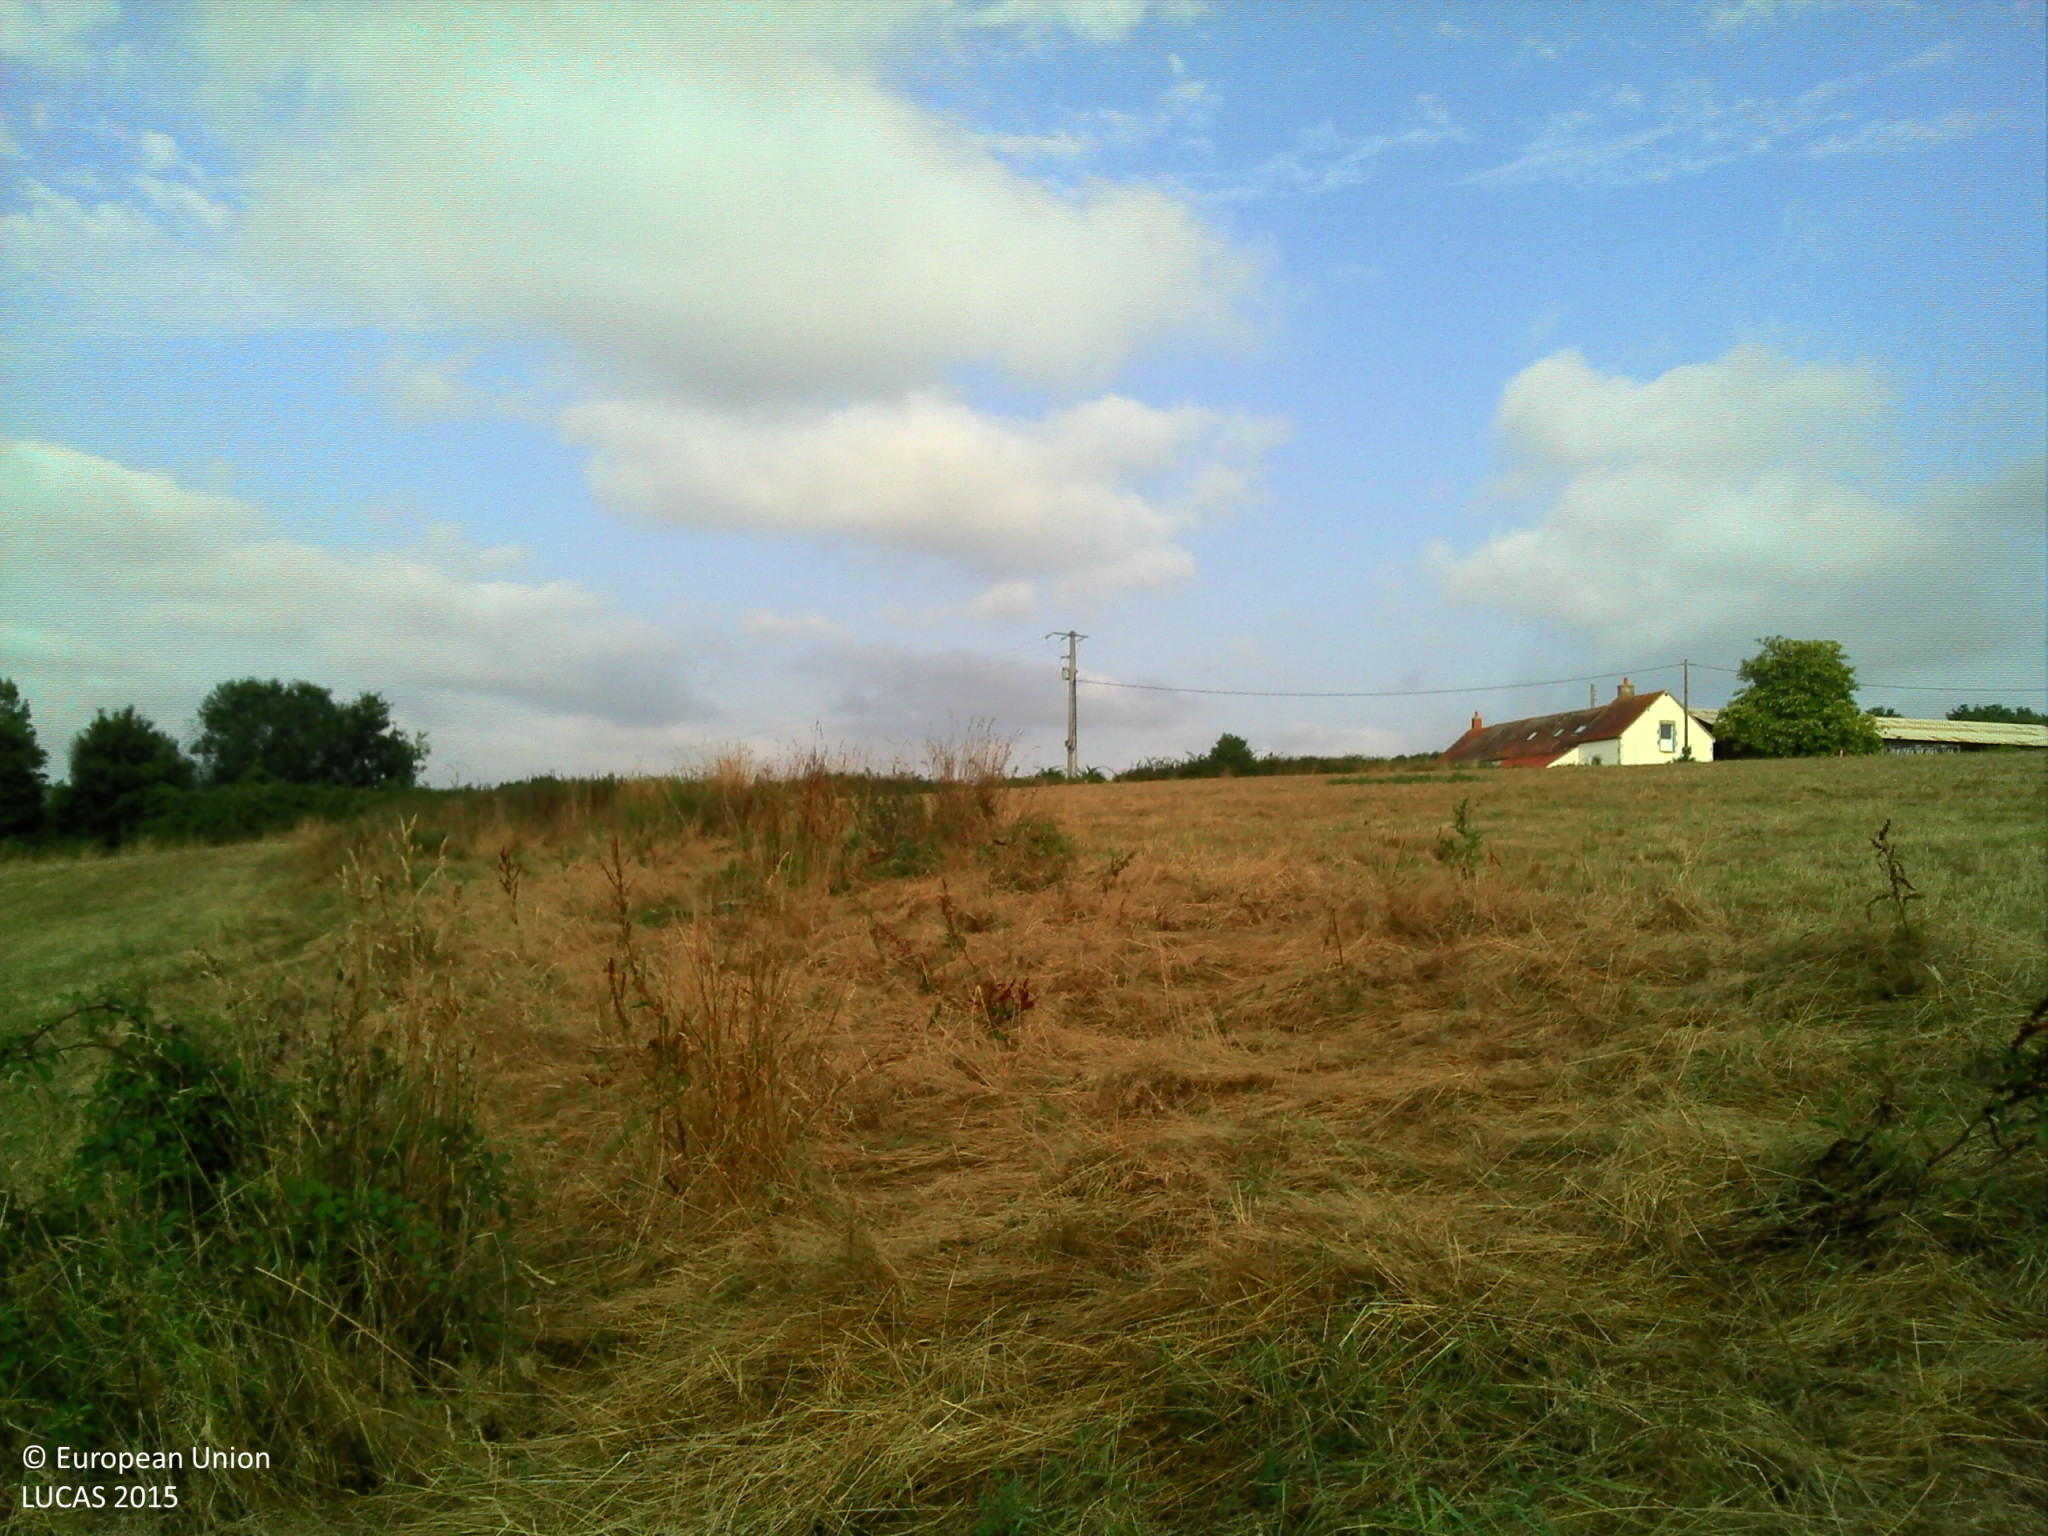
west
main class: Grassland
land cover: Grassland without tree/shrub cover
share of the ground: > 75 %
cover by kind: herbaceous plants 100 %
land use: Agriculture (excluding fallow land and kitchen gardens)
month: July
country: FR
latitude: 46.7914
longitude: 3.0138
